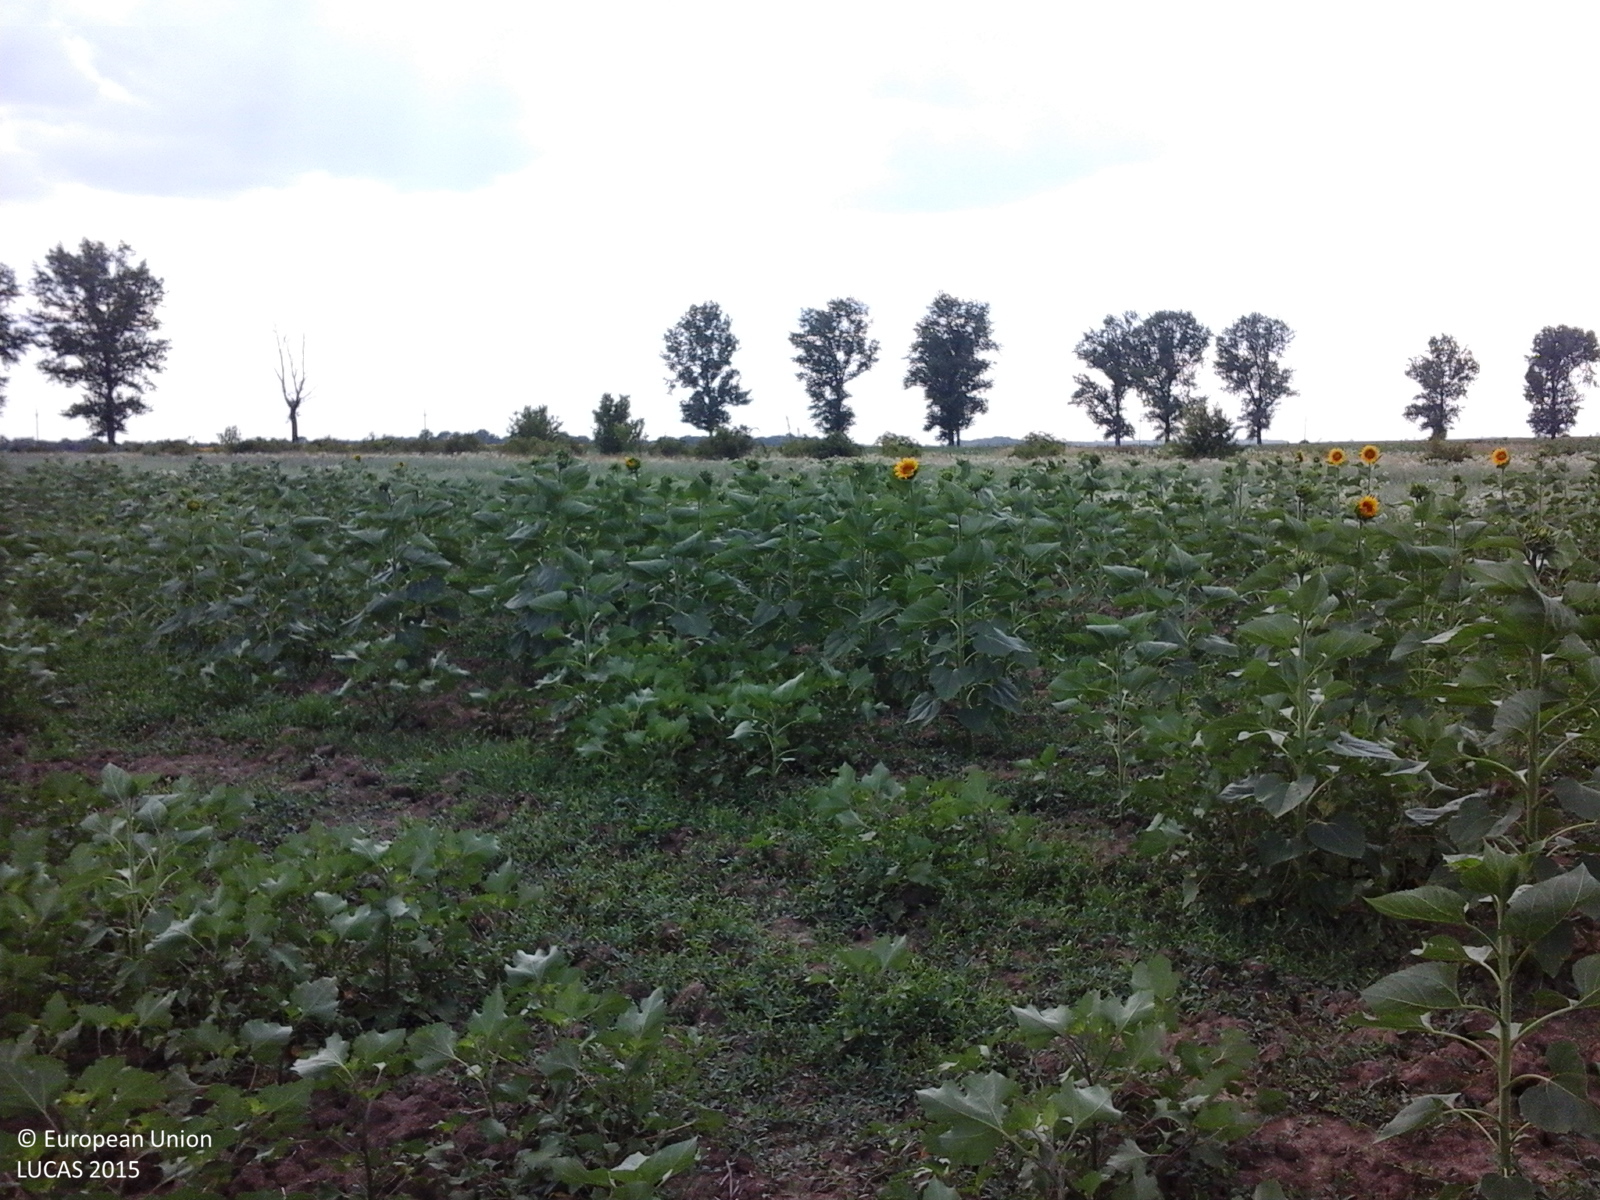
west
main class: Cropland
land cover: Sunflower
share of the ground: > 75 %
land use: Agriculture (excluding fallow land and kitchen gardens)
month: July
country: RO
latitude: 44.1976
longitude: 24.9291
